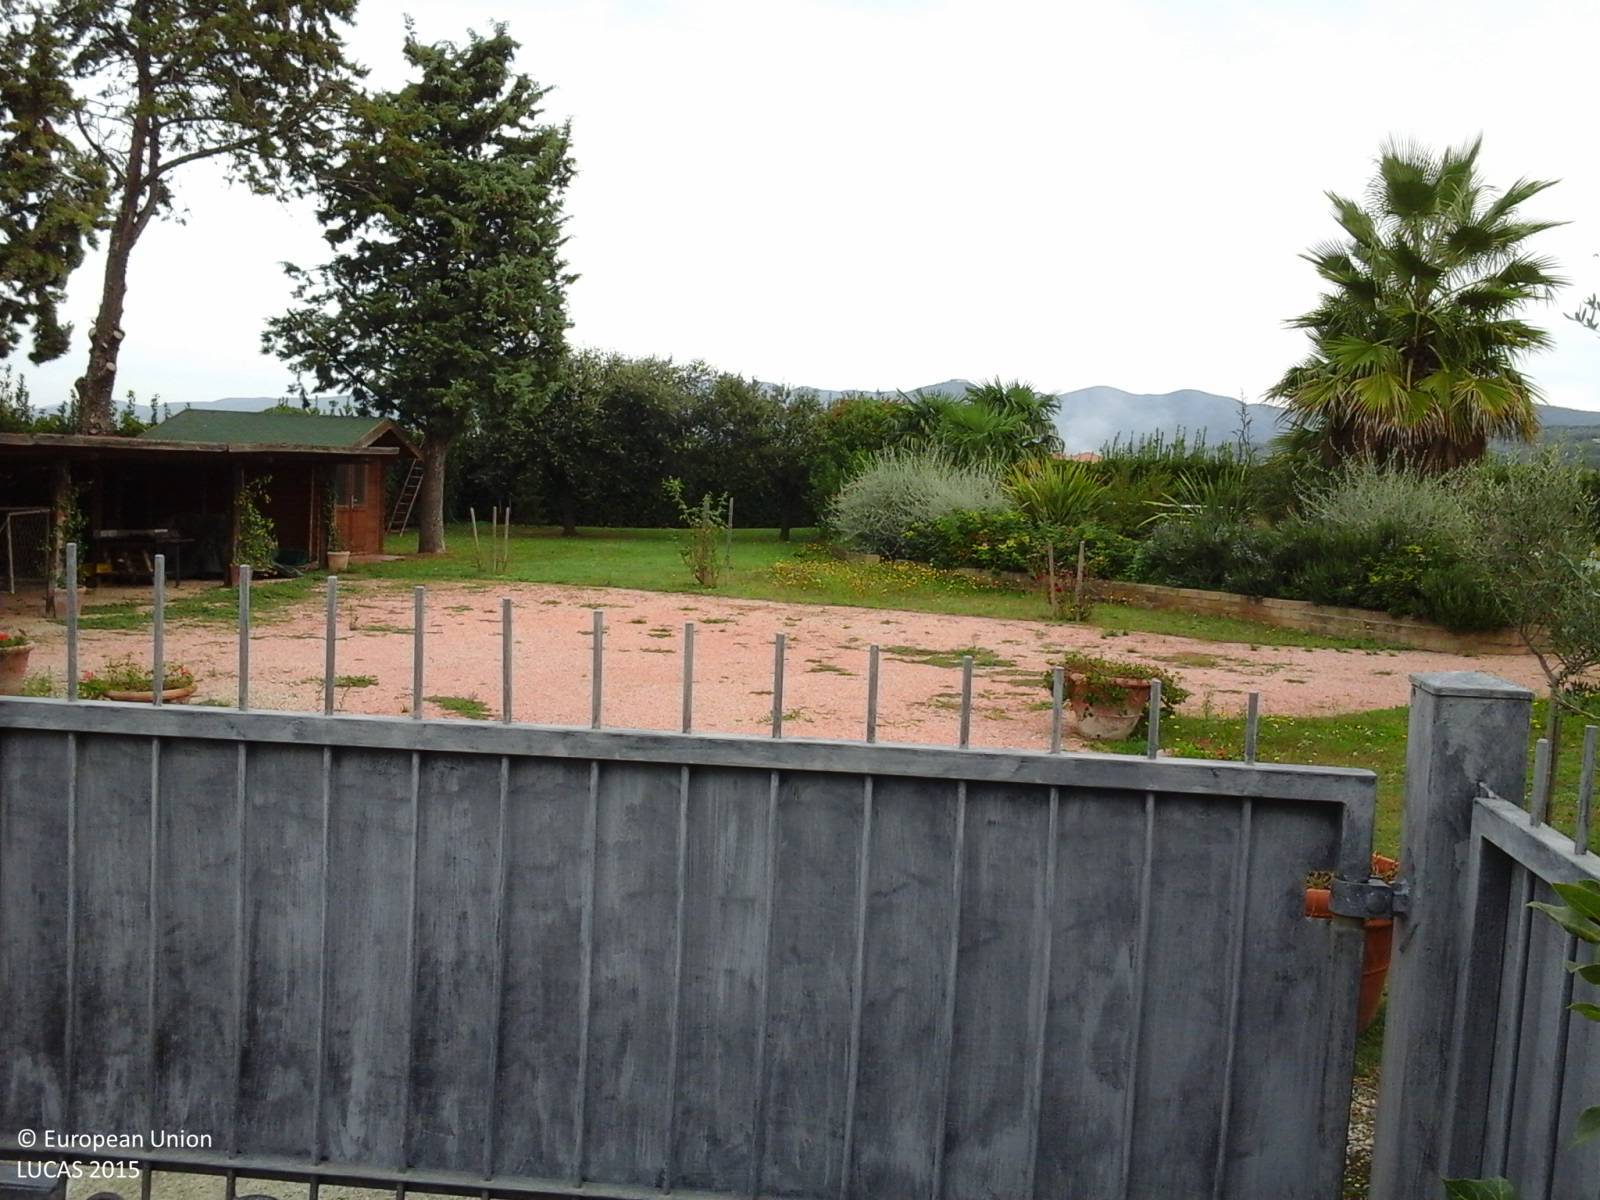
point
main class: Grassland
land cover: Grassland with sparse tree/shrub cover
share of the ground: 25 - 50 %
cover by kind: herbaceous plants 90 %, broadleaved forest trees 5 %, shrubs 5 %
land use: Residential
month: October
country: IT
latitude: 43.1759
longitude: 10.6010
